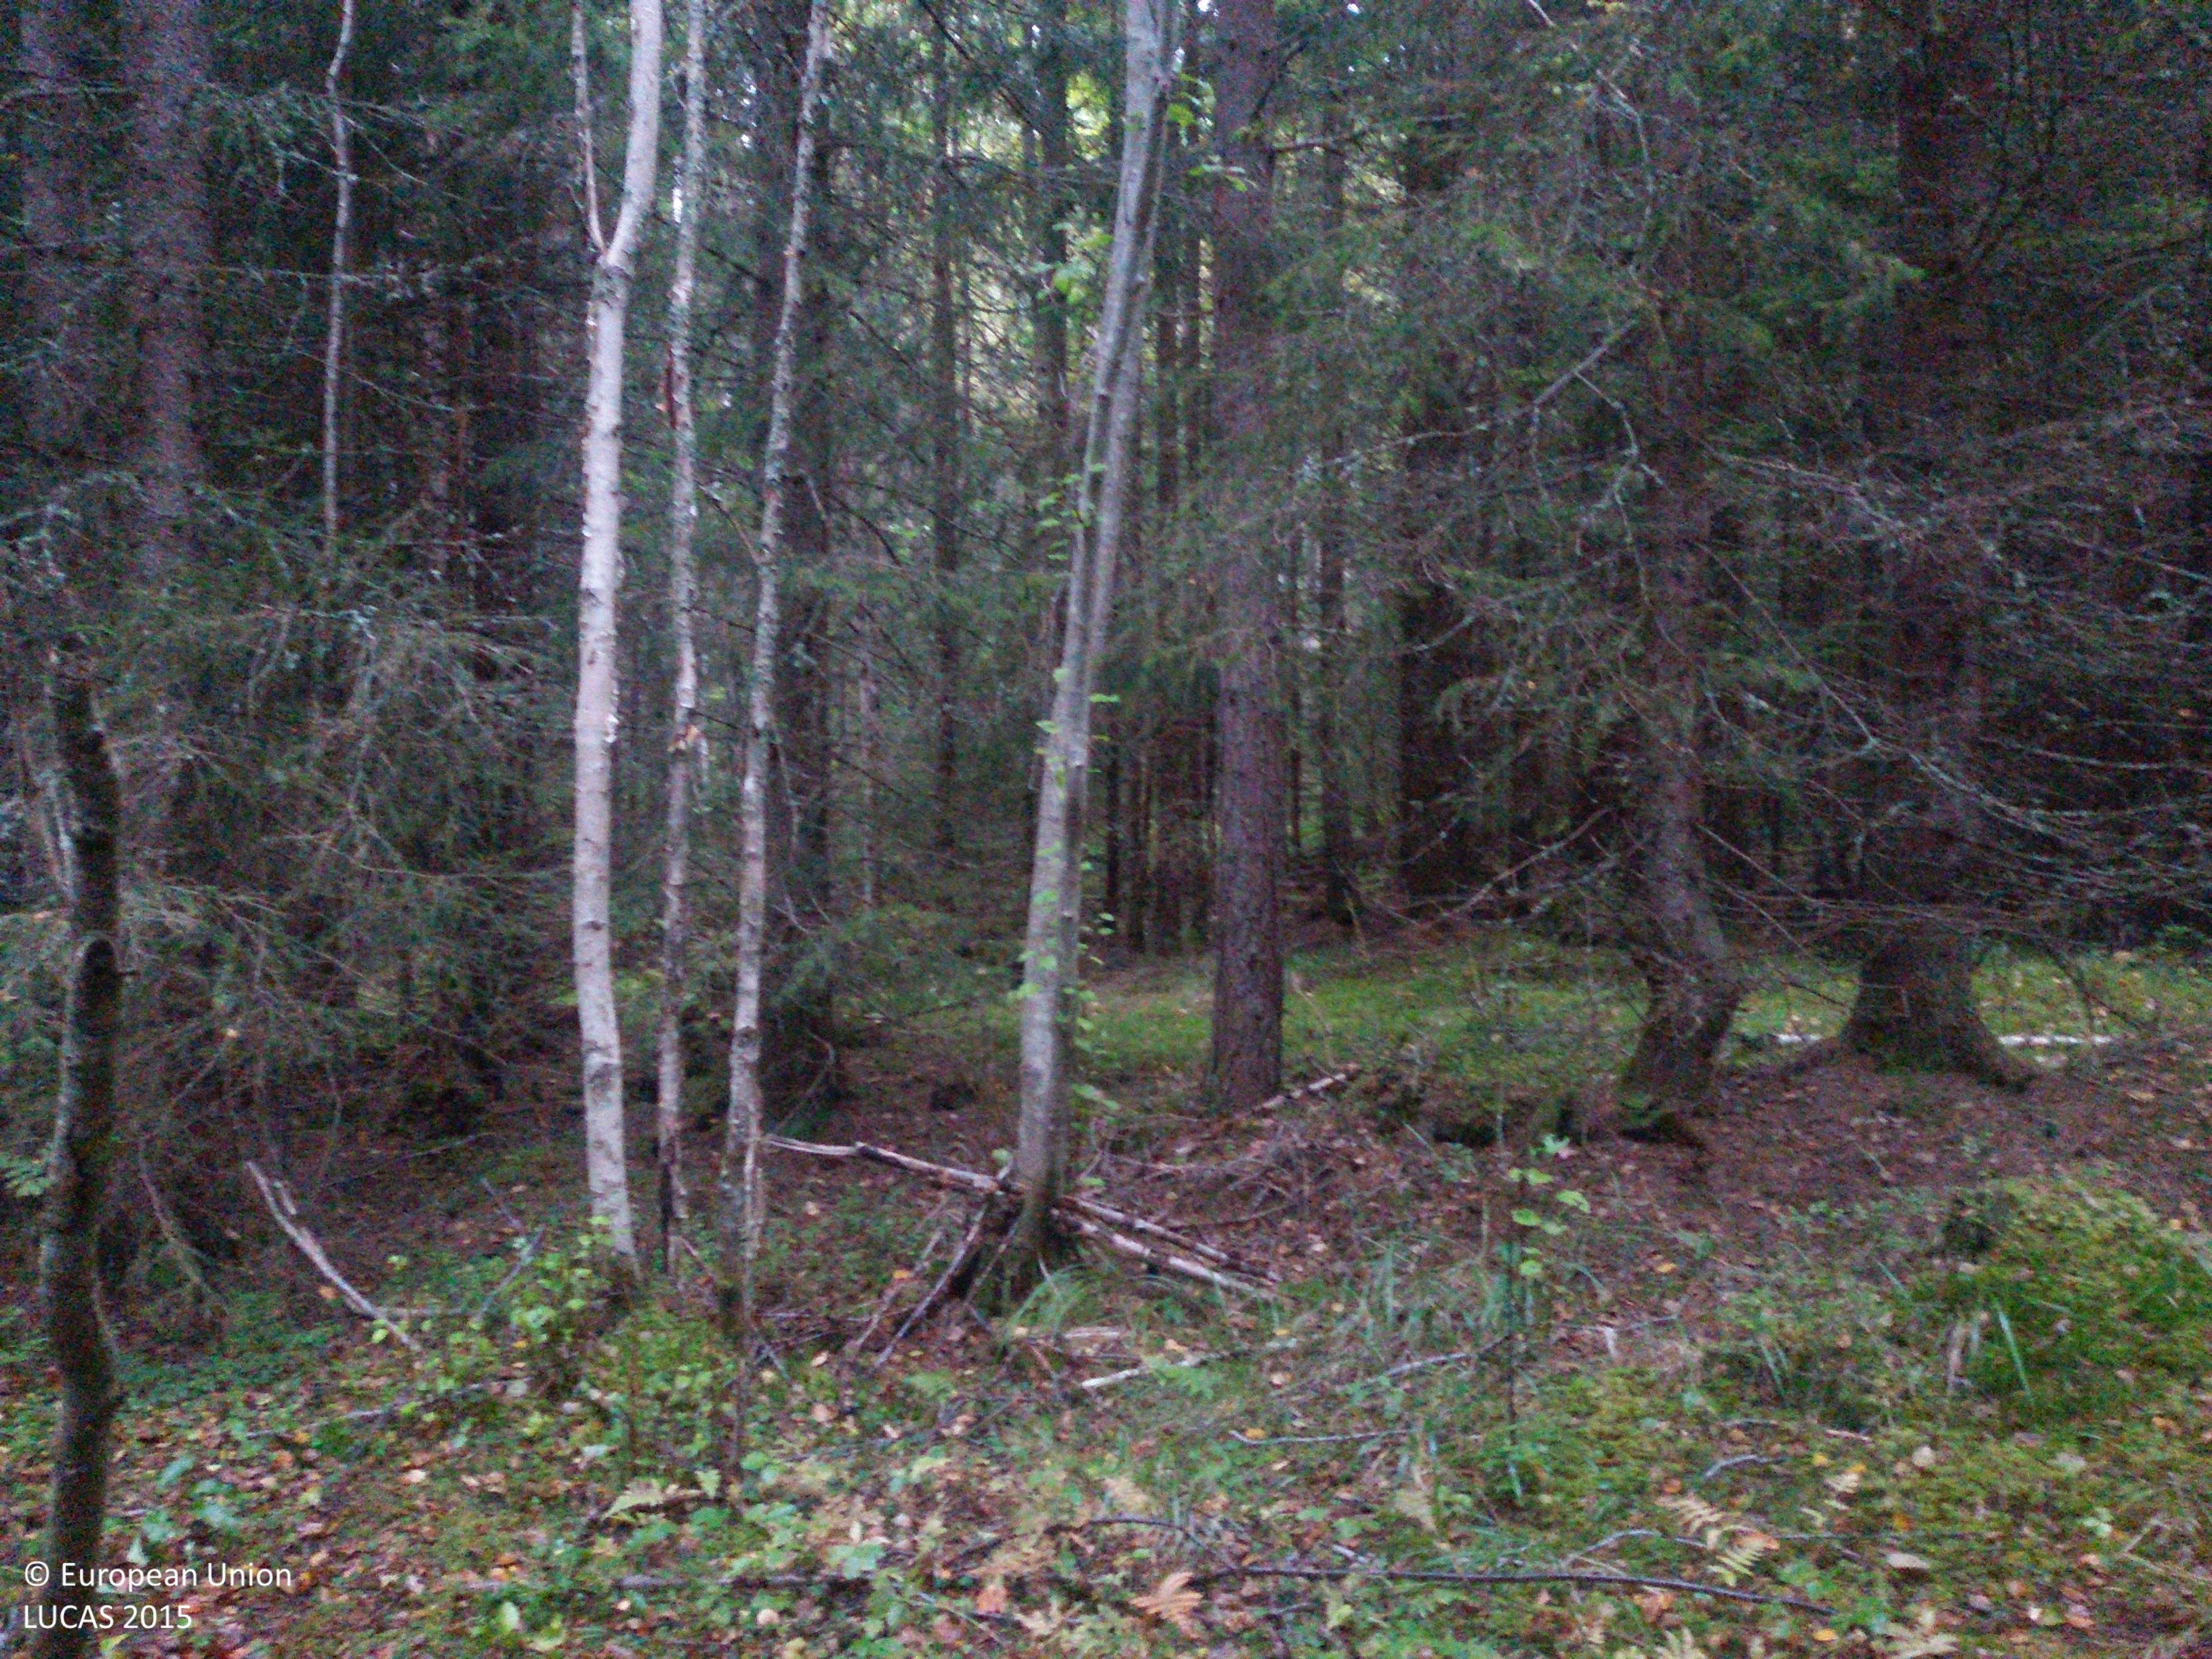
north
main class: Woodland
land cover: Spruce dominated mixed woodland
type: boreal forest
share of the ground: > 75 %
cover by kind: coniferous forest trees 55 %, broadleaved forest trees 35 %, herbaceous plants 10 %
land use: Forestry
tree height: > 5 m
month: September
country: SE
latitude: 60.7097
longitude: 14.8797
